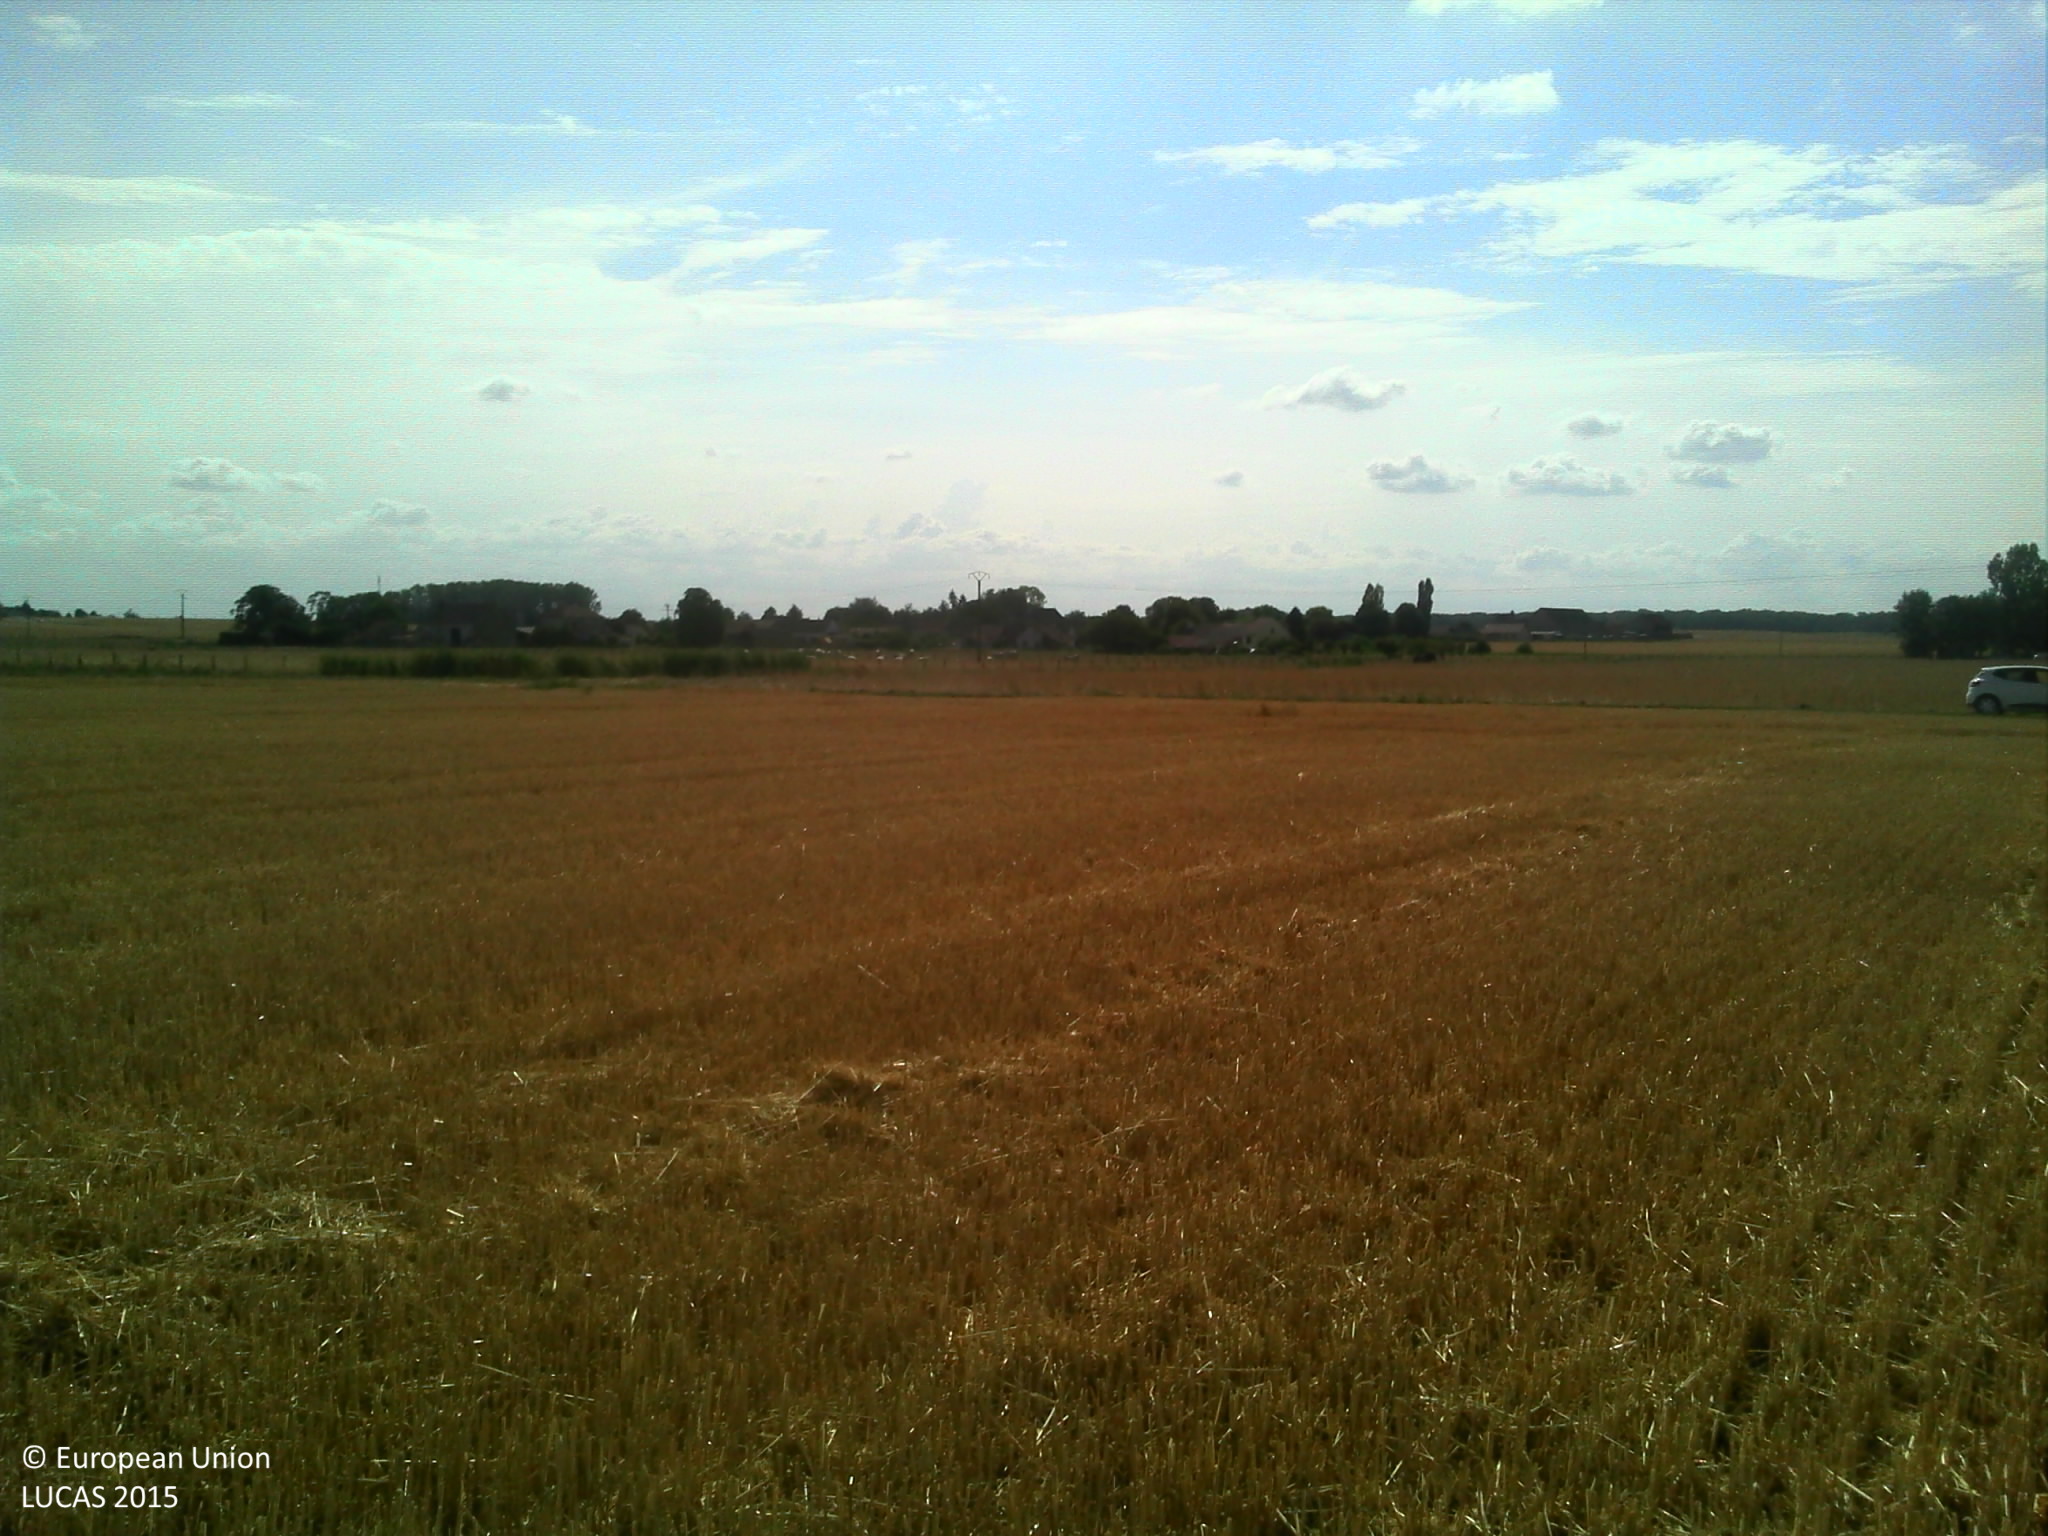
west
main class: Cropland
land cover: Common wheat
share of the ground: > 75 %
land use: Agriculture (excluding fallow land and kitchen gardens)
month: July
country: FR
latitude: 46.9198
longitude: 4.9981
